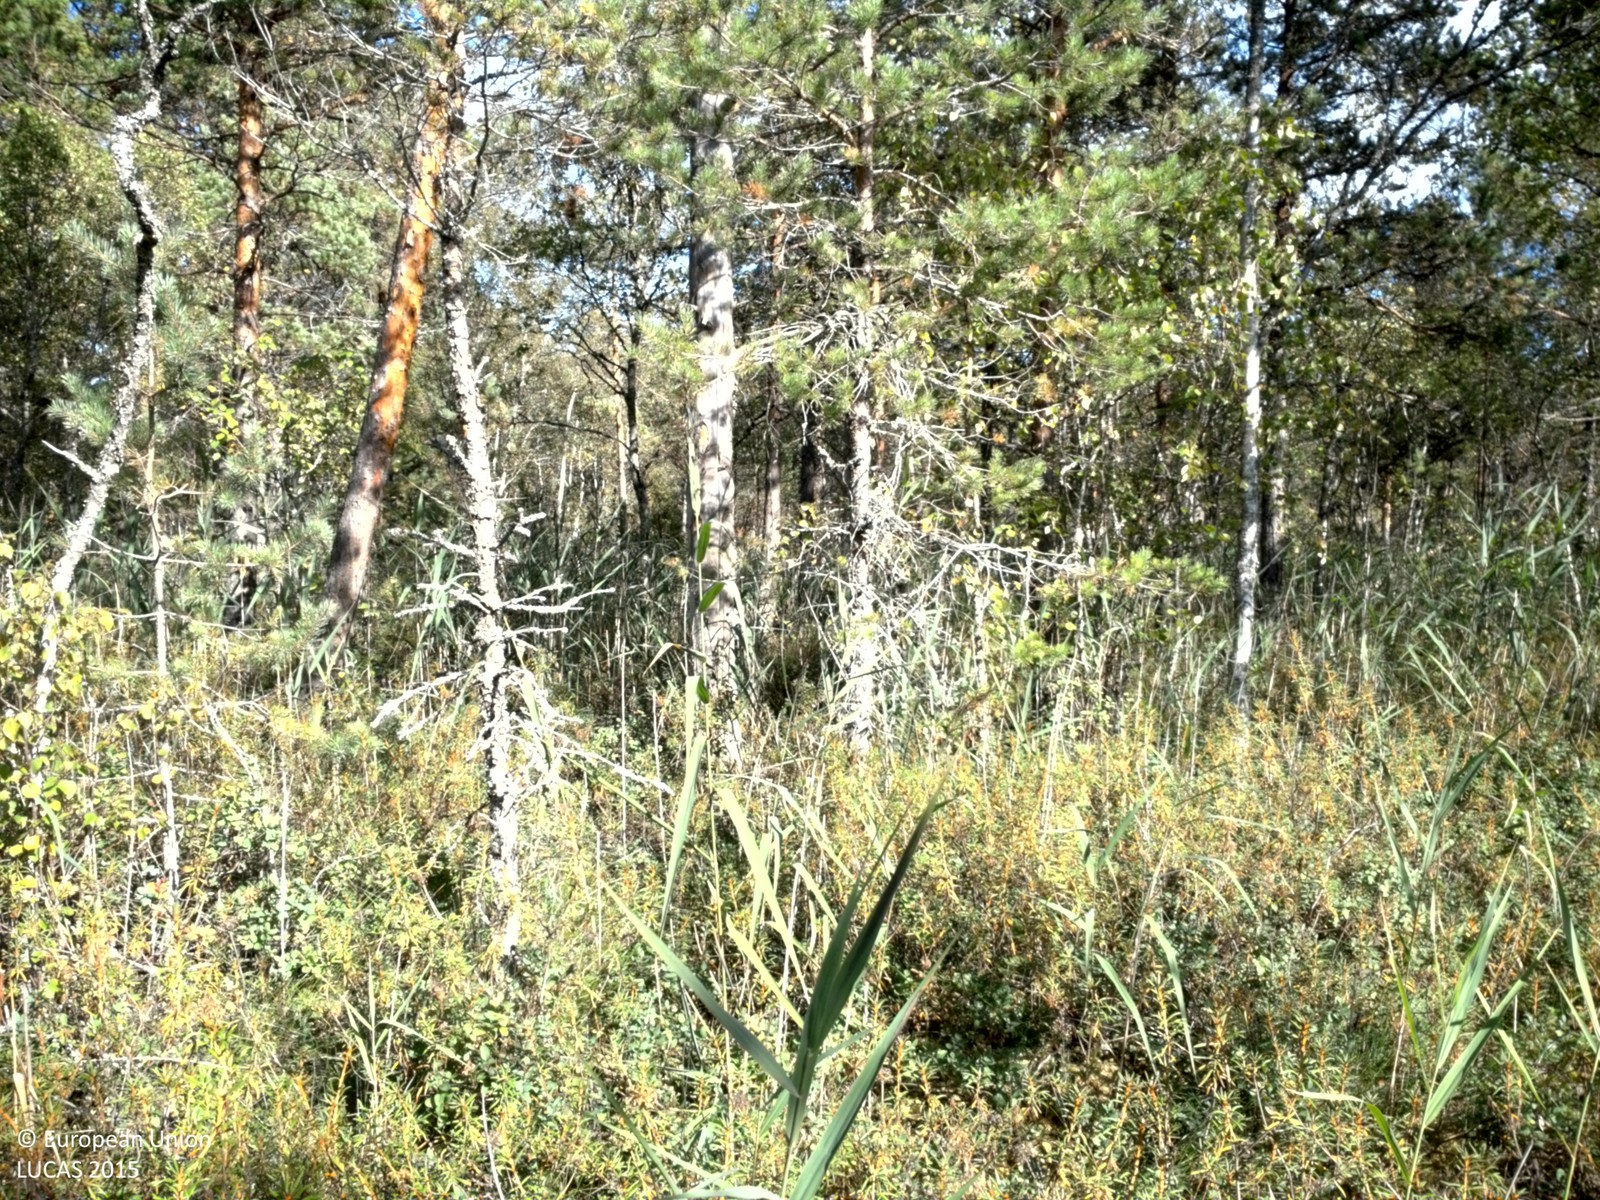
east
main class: Woodland
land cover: Pine dominated coniferous woodland
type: boreal forest
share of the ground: 25 - 50 %
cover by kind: lichens and mosses 55 %, coniferous forest trees 30 %, herbaceous plants 10 %, shrubs 5 %
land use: Forestry
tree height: < 5 m
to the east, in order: Pine dominated coniferous woodland; Pine dominated mixed woodland; Pine dominated coniferous woodland; Pine dominated mixed woodland
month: August
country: SE
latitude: 59.7867
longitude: 17.7449
